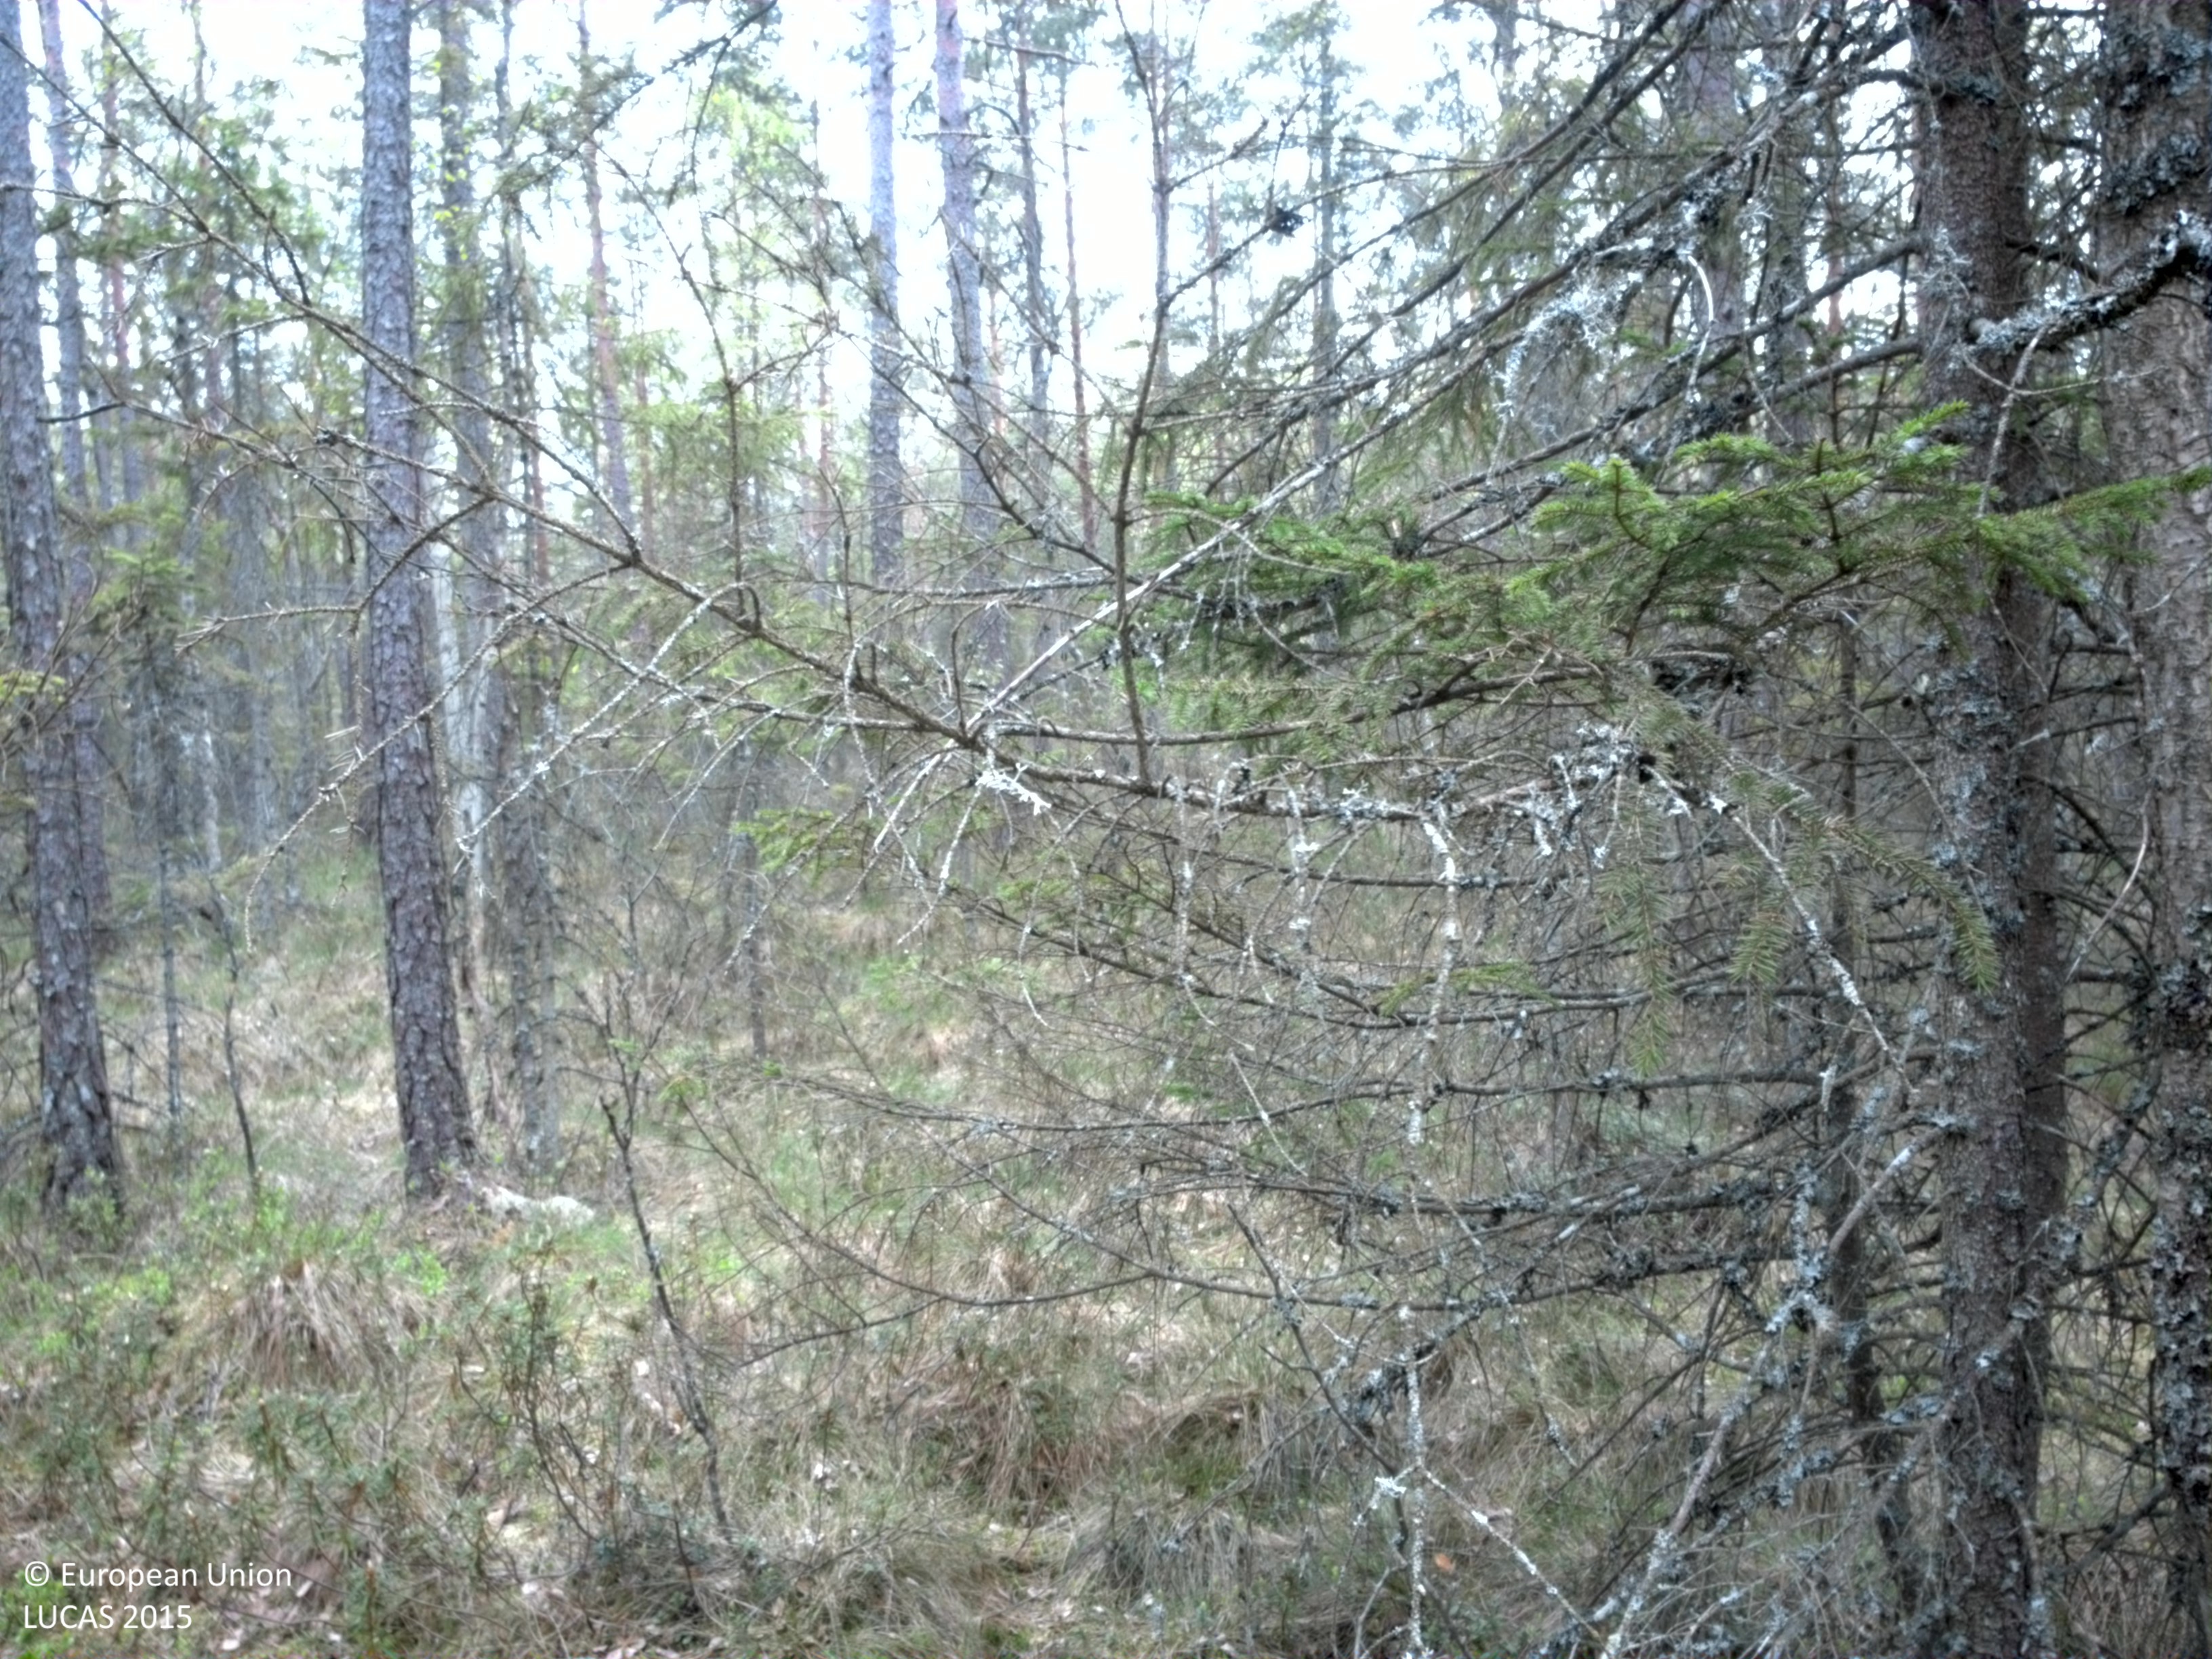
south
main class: Woodland
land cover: Pine dominated coniferous woodland
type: boreal forest
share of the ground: > 75 %
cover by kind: coniferous forest trees 60 %, broadleaved forest trees 20 %, lichens and mosses 20 %
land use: Forestry
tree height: > 5 m
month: May
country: SE
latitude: 56.7957
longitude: 15.3849
